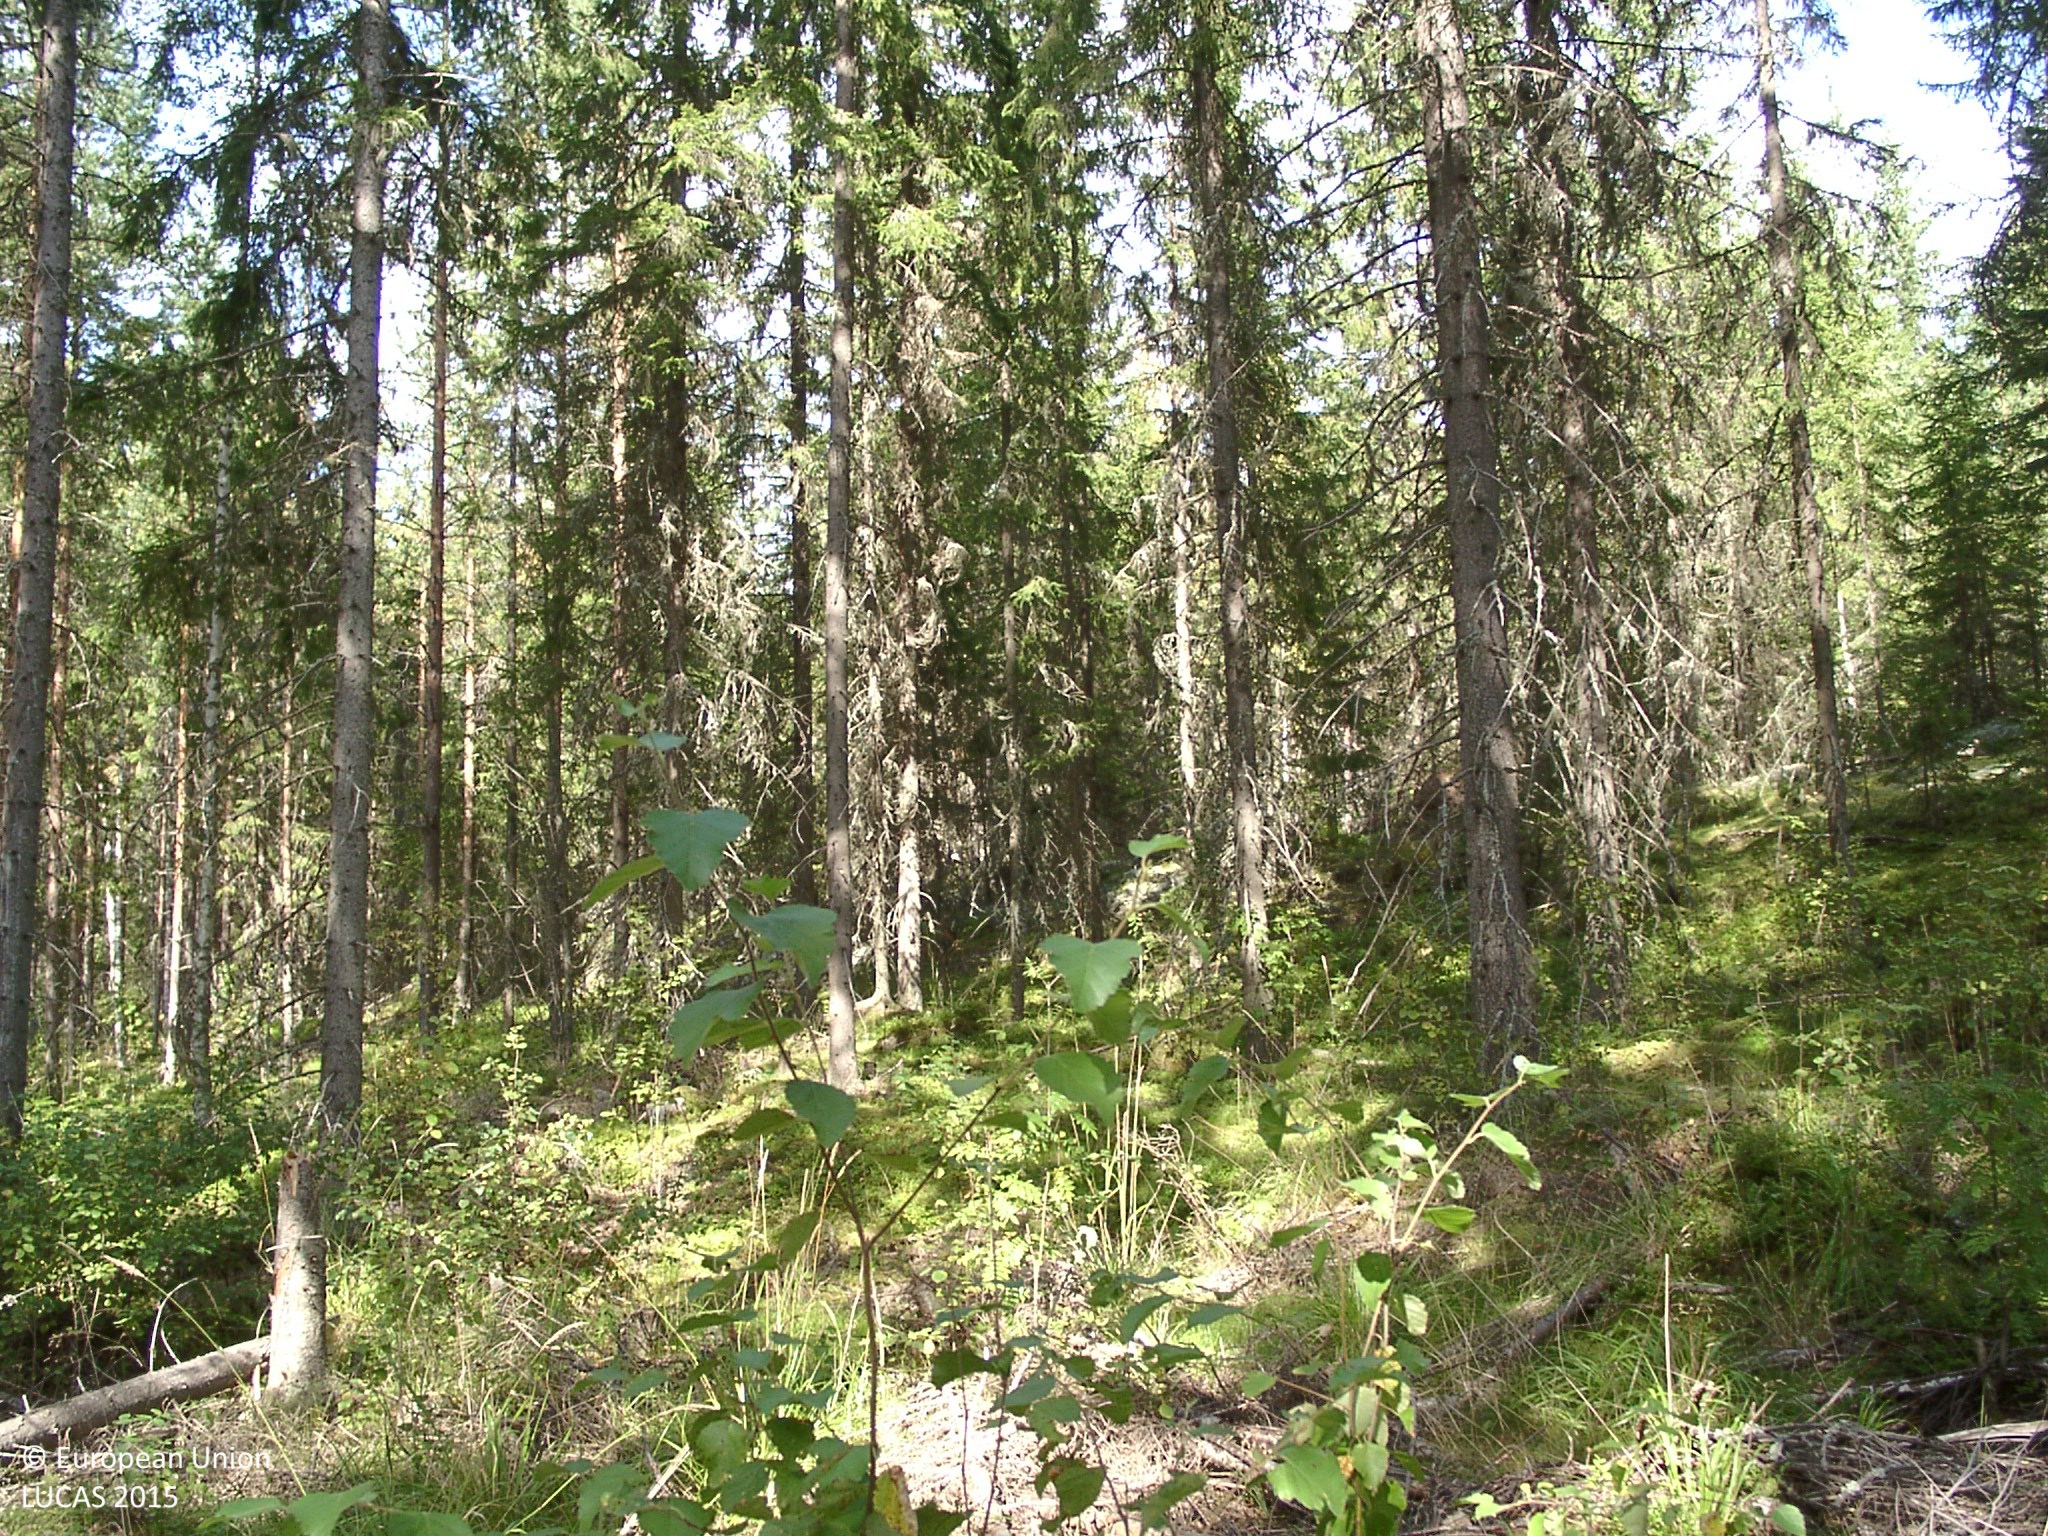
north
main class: Woodland
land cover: Spruce dominated coniferous woodland
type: boreal forest
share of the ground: 50 - 75 %
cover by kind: coniferous forest trees 65 %, lichens and mosses 10 %, shrubs 5 %, herbaceous plants 5 %, unconsolidated bare surface 5 %
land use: Forestry
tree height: > 5 m
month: August
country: FI
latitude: 61.7707
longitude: 25.0999
